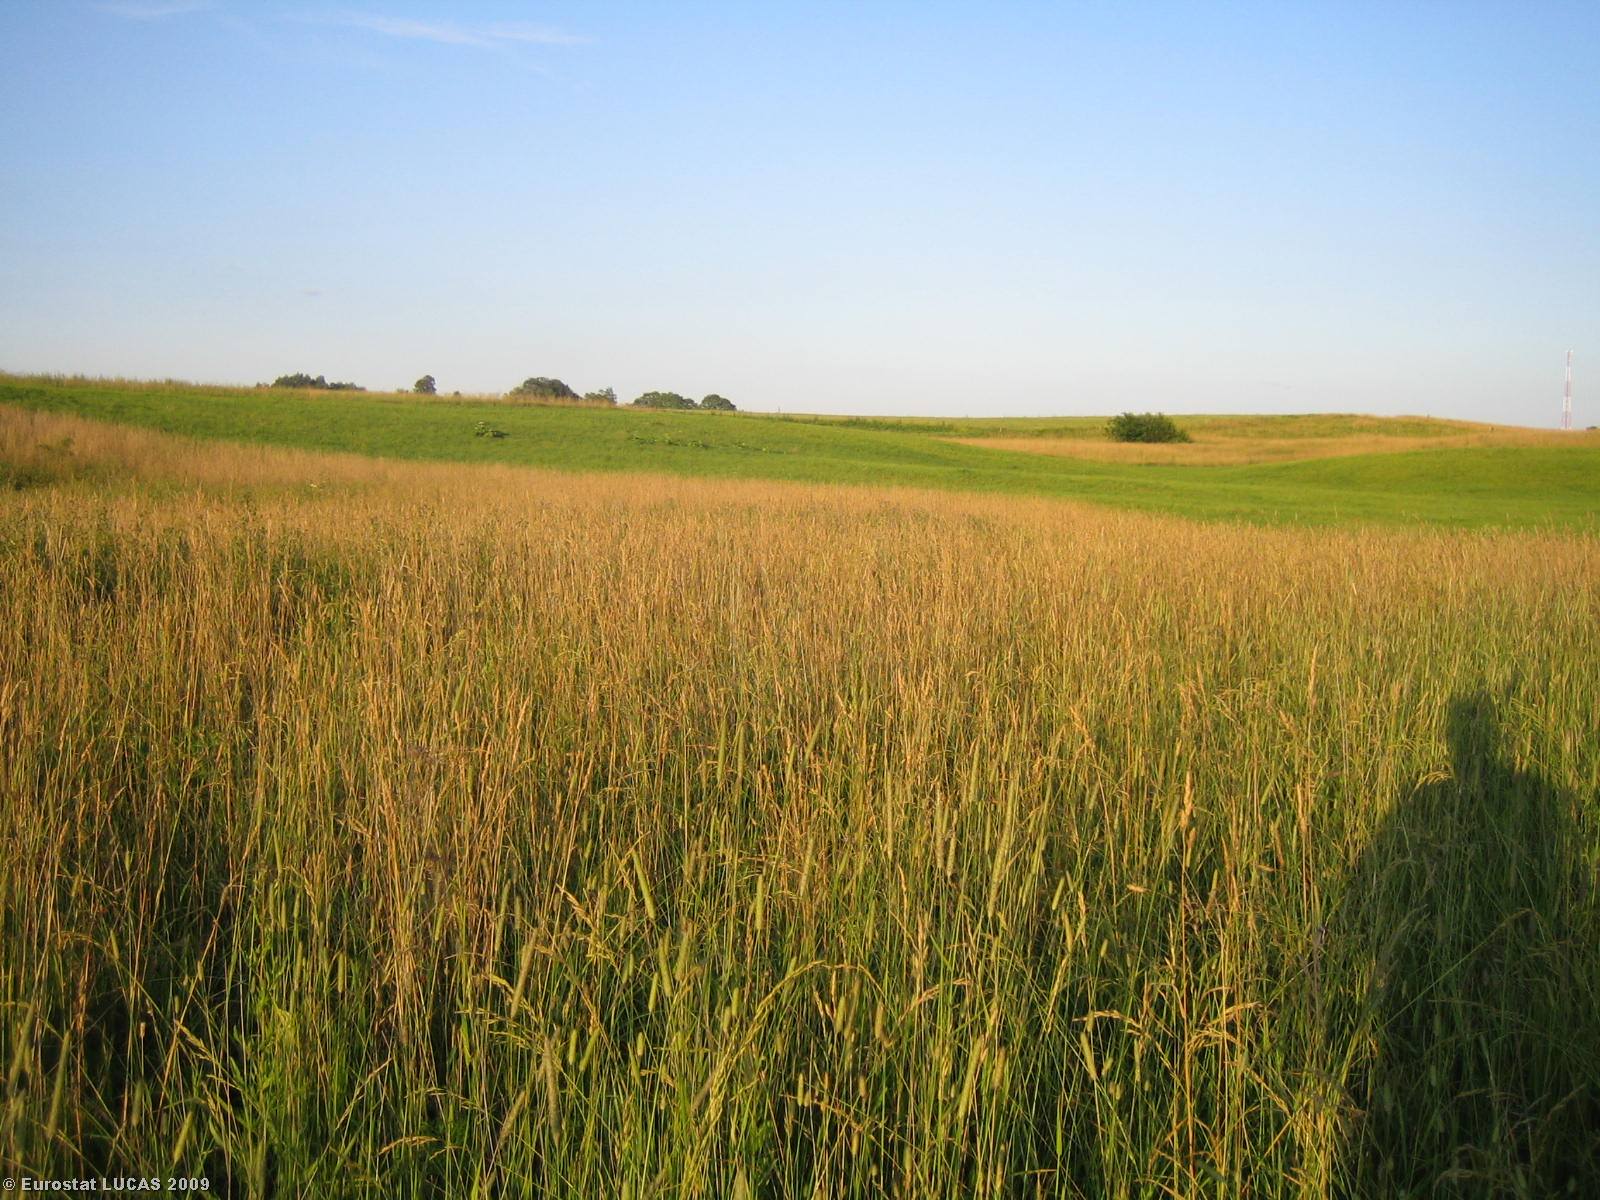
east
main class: Grassland
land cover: Grassland without tree/shrub cover
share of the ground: > 75 %
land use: Agriculture (excluding fallow land and kitchen gardens)
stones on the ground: < 10 %
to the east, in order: Grassland without tree/shrub cover; Potatoes; Common wheat
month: July
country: LT
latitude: 55.8460
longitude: 26.0615
